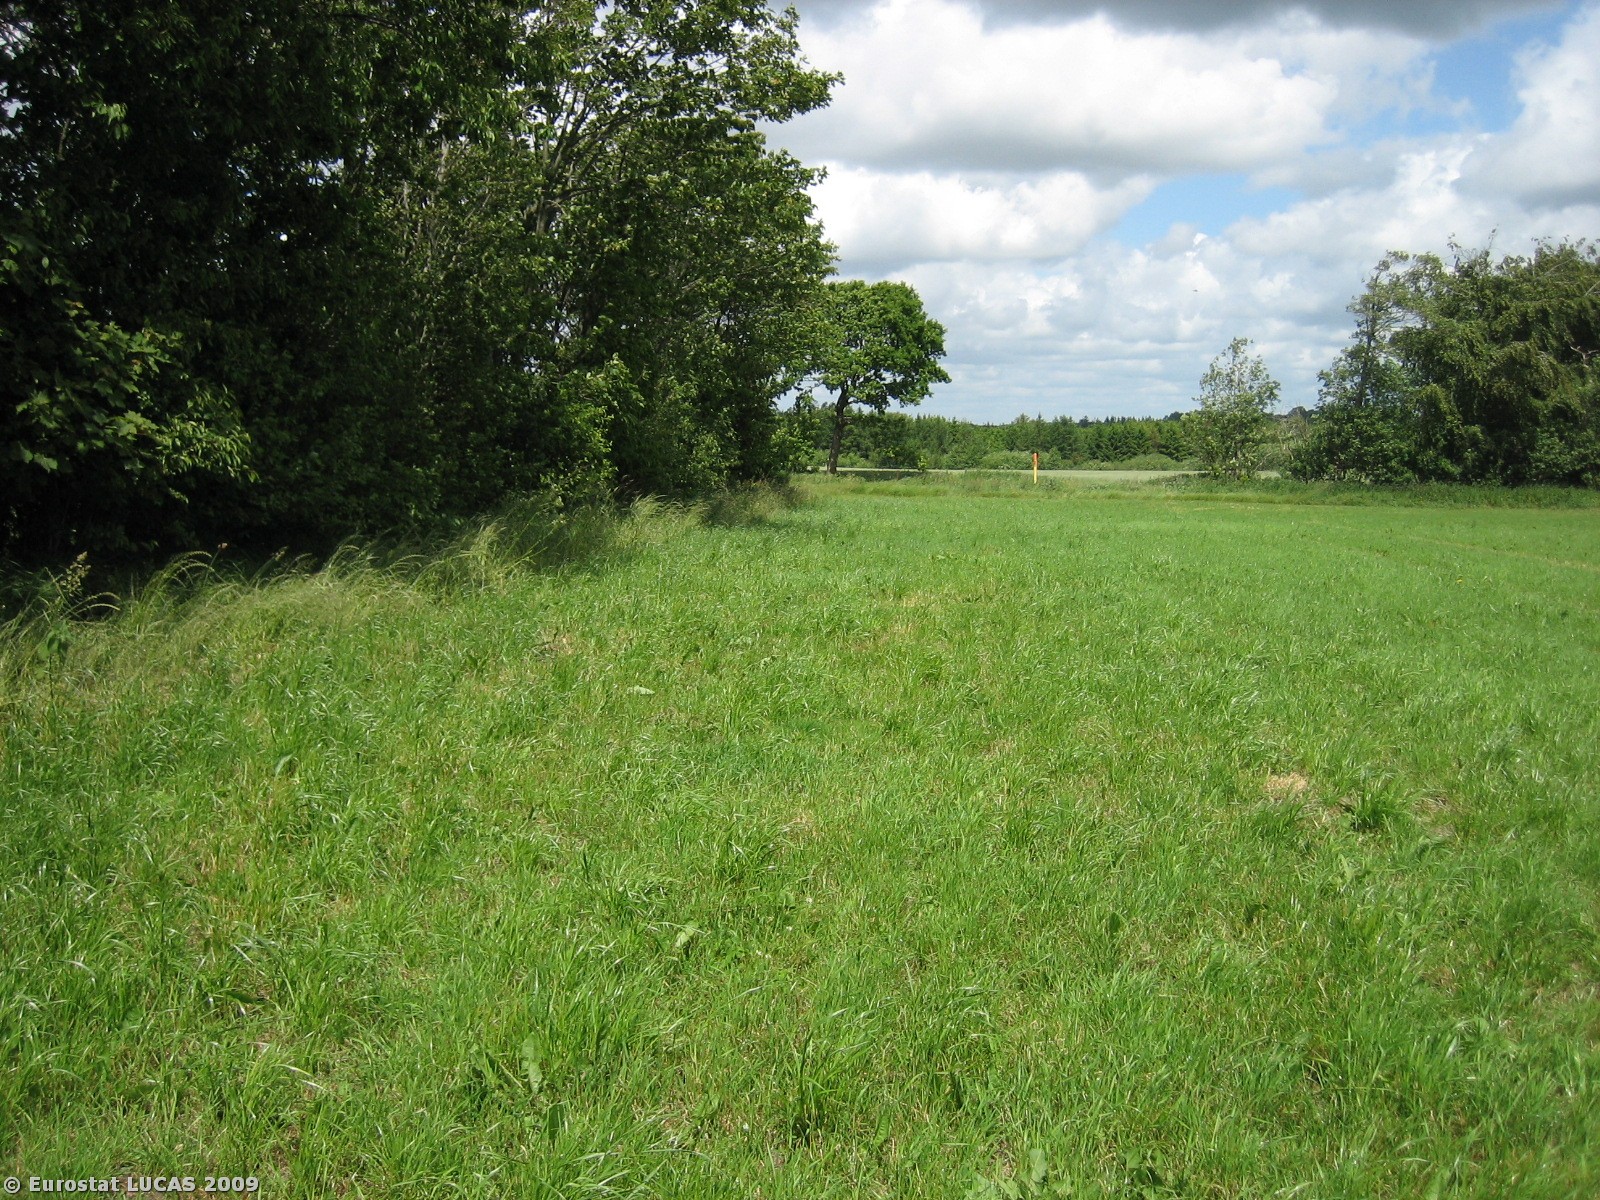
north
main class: Cropland
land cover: Temporary grasslands
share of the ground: > 75 %
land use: Agriculture (excluding fallow land and kitchen gardens)
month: June
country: DK
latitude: 55.7719
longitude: 9.2197
